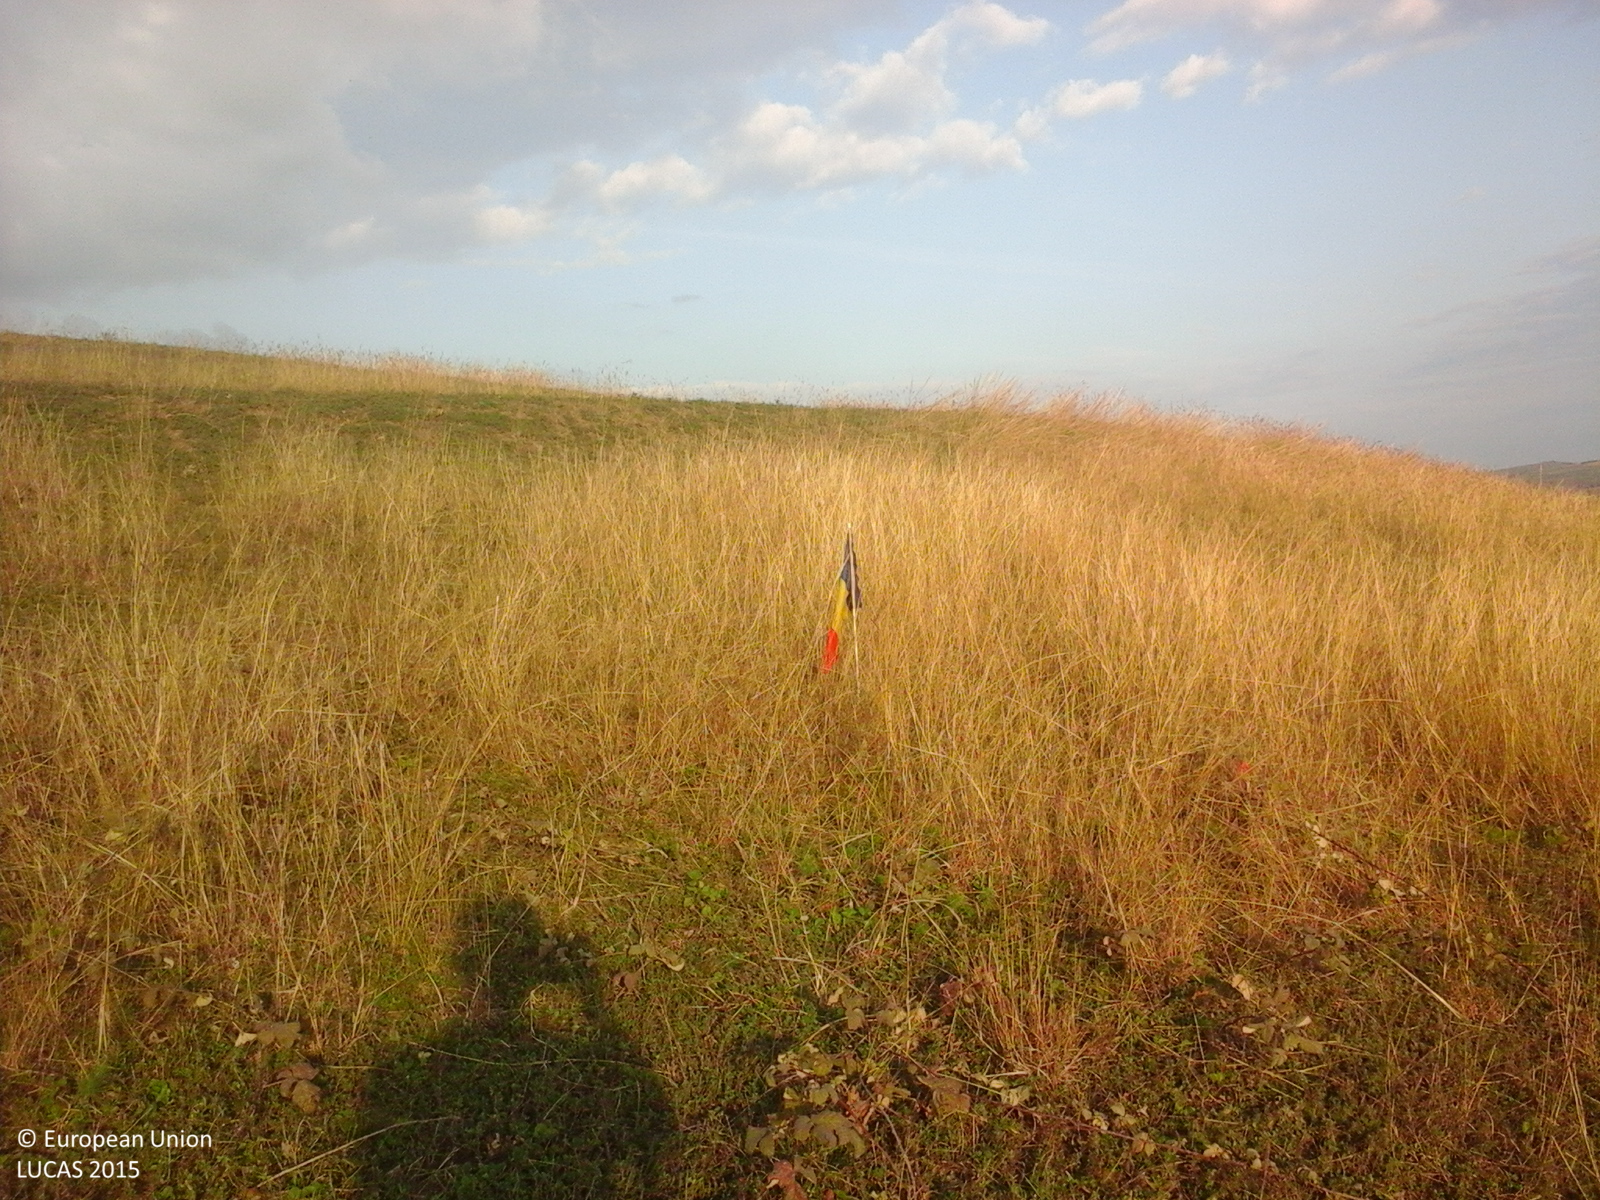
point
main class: Grassland
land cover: Grassland without tree/shrub cover
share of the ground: > 75 %
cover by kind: herbaceous plants 100 %
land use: Agriculture (excluding fallow land and kitchen gardens)
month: October
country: RO
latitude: 46.4876
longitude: 23.9765
